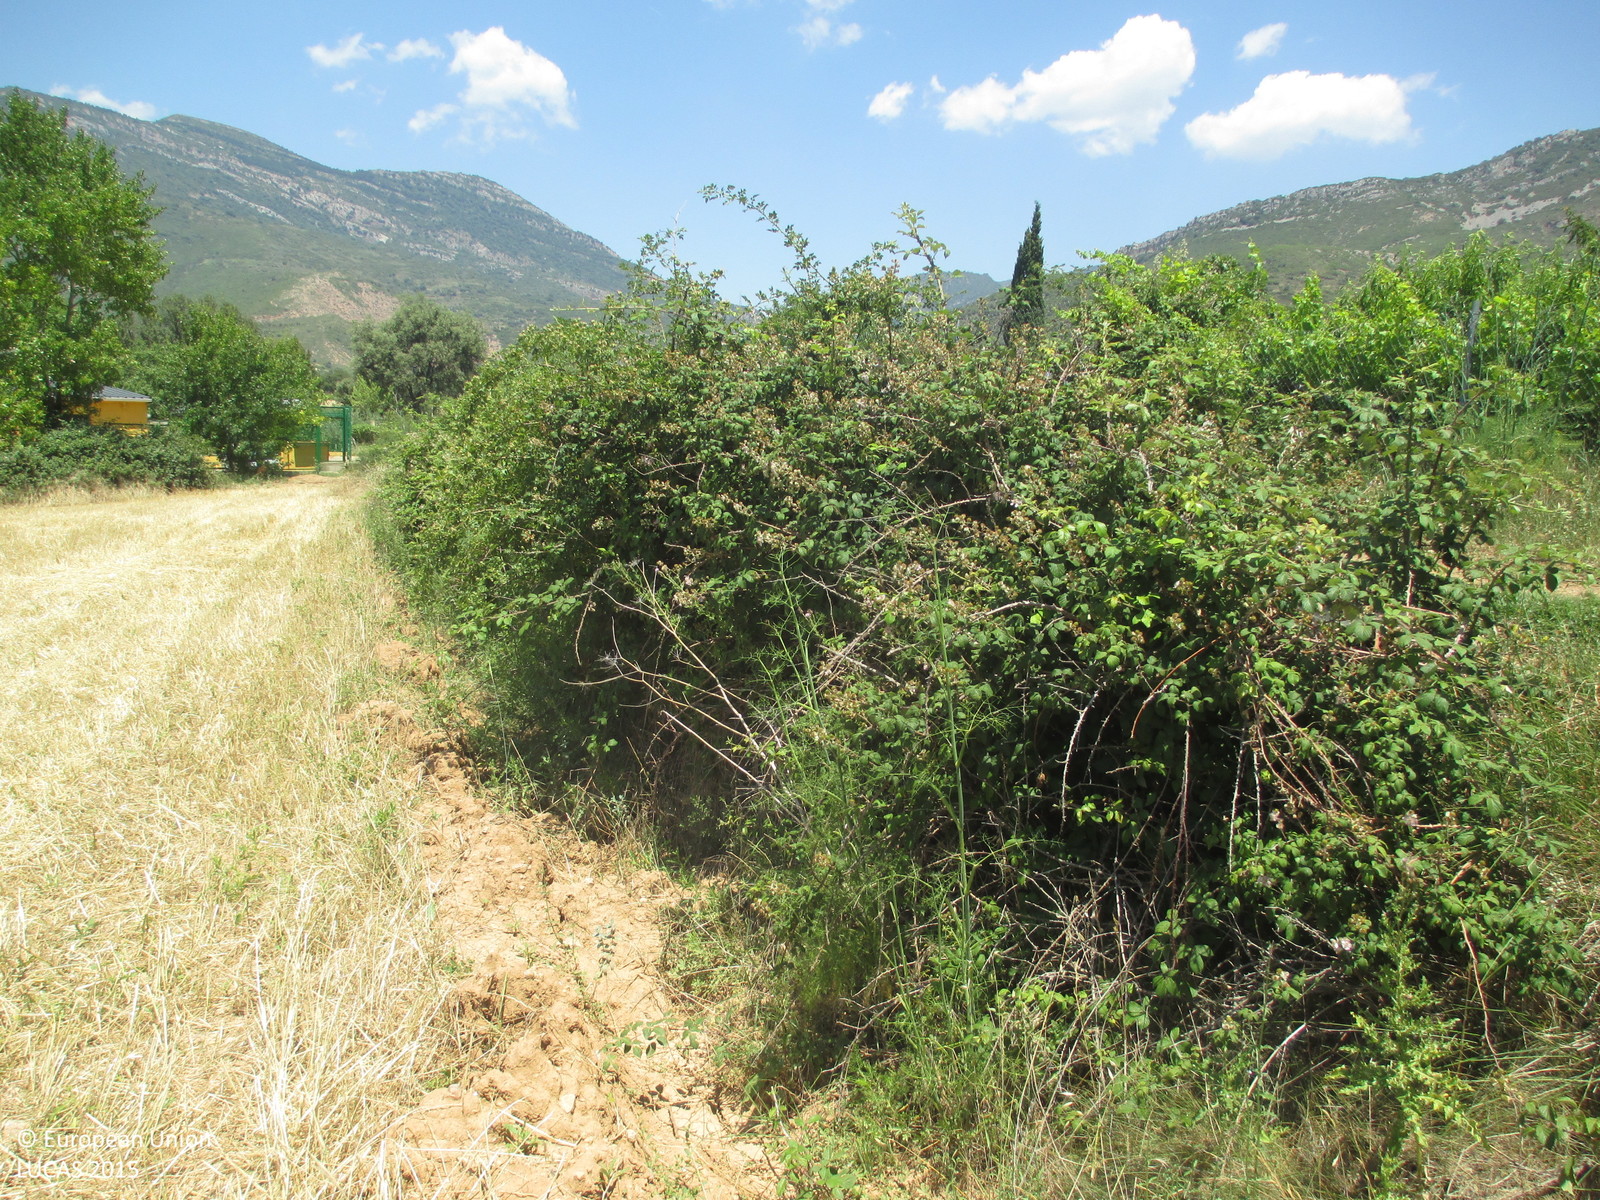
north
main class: Cropland
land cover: Barley
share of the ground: < 10 %
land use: Agriculture (excluding fallow land and kitchen gardens)
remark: Harvested field
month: June
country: ES
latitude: 42.2590
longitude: -0.4366
